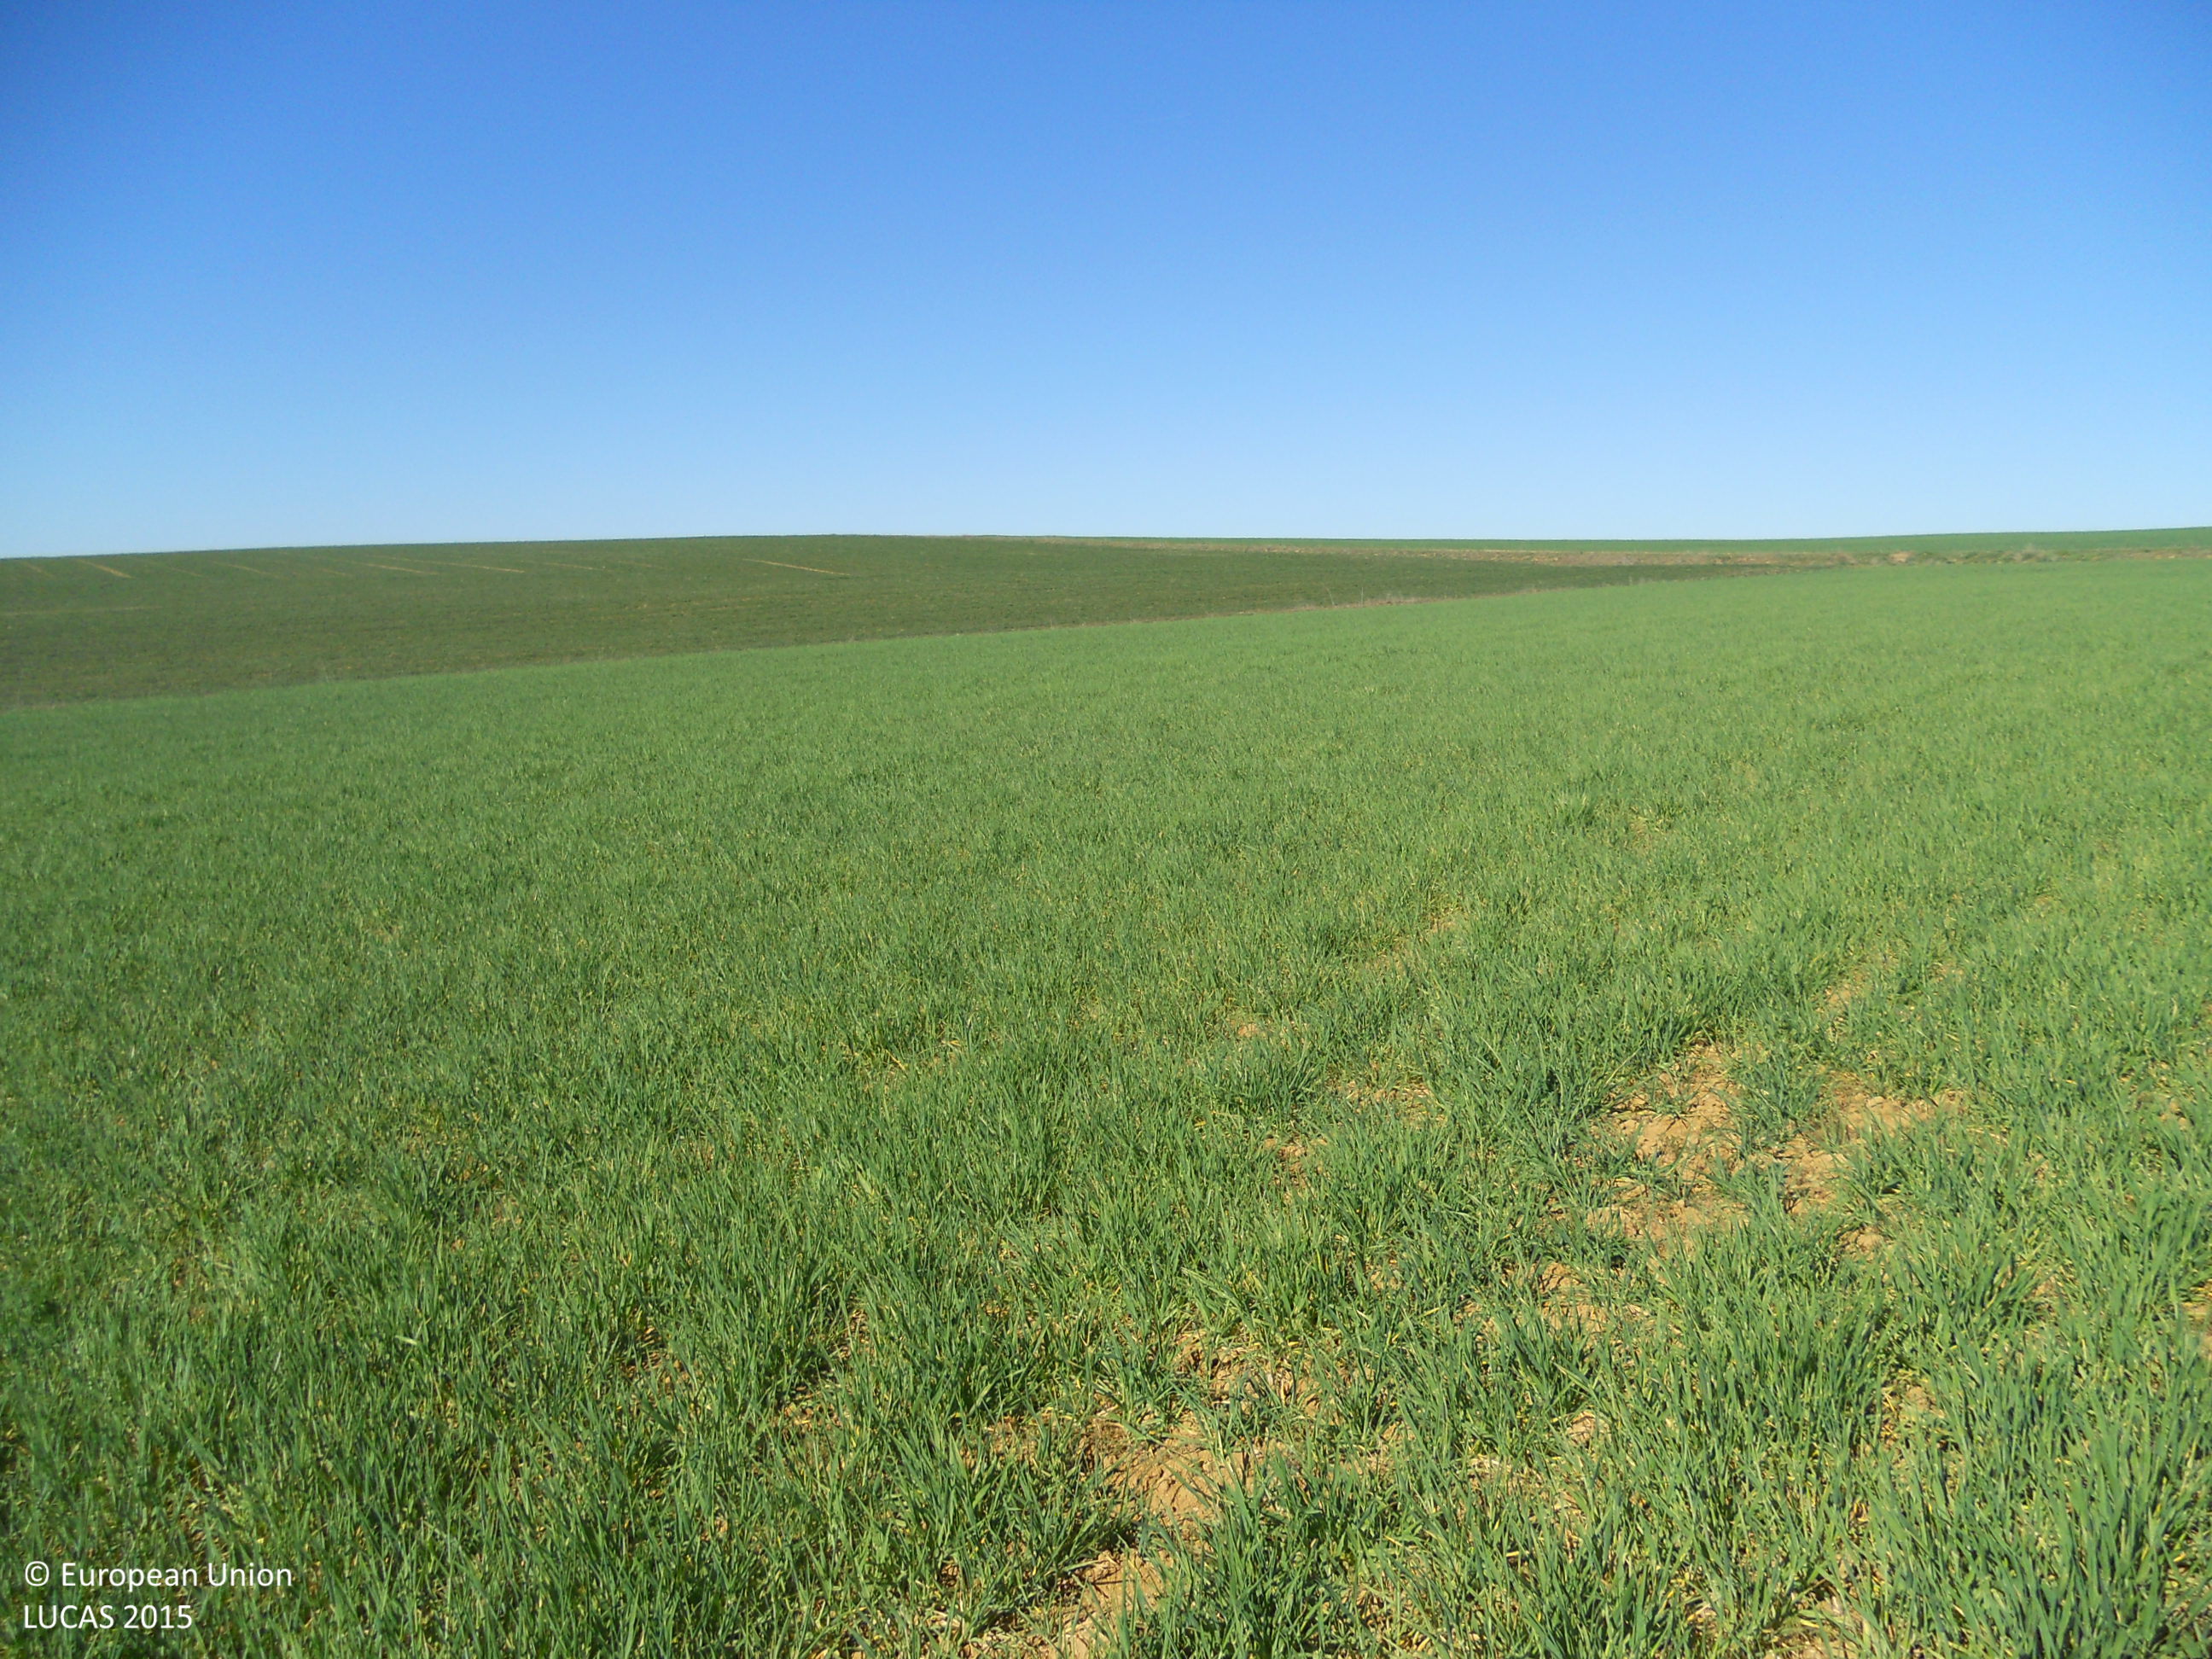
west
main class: Cropland
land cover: Barley
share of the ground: > 75 %
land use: Agriculture (excluding fallow land and kitchen gardens)
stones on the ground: < 10 %
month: April
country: ES
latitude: 42.2414
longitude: -4.7773
